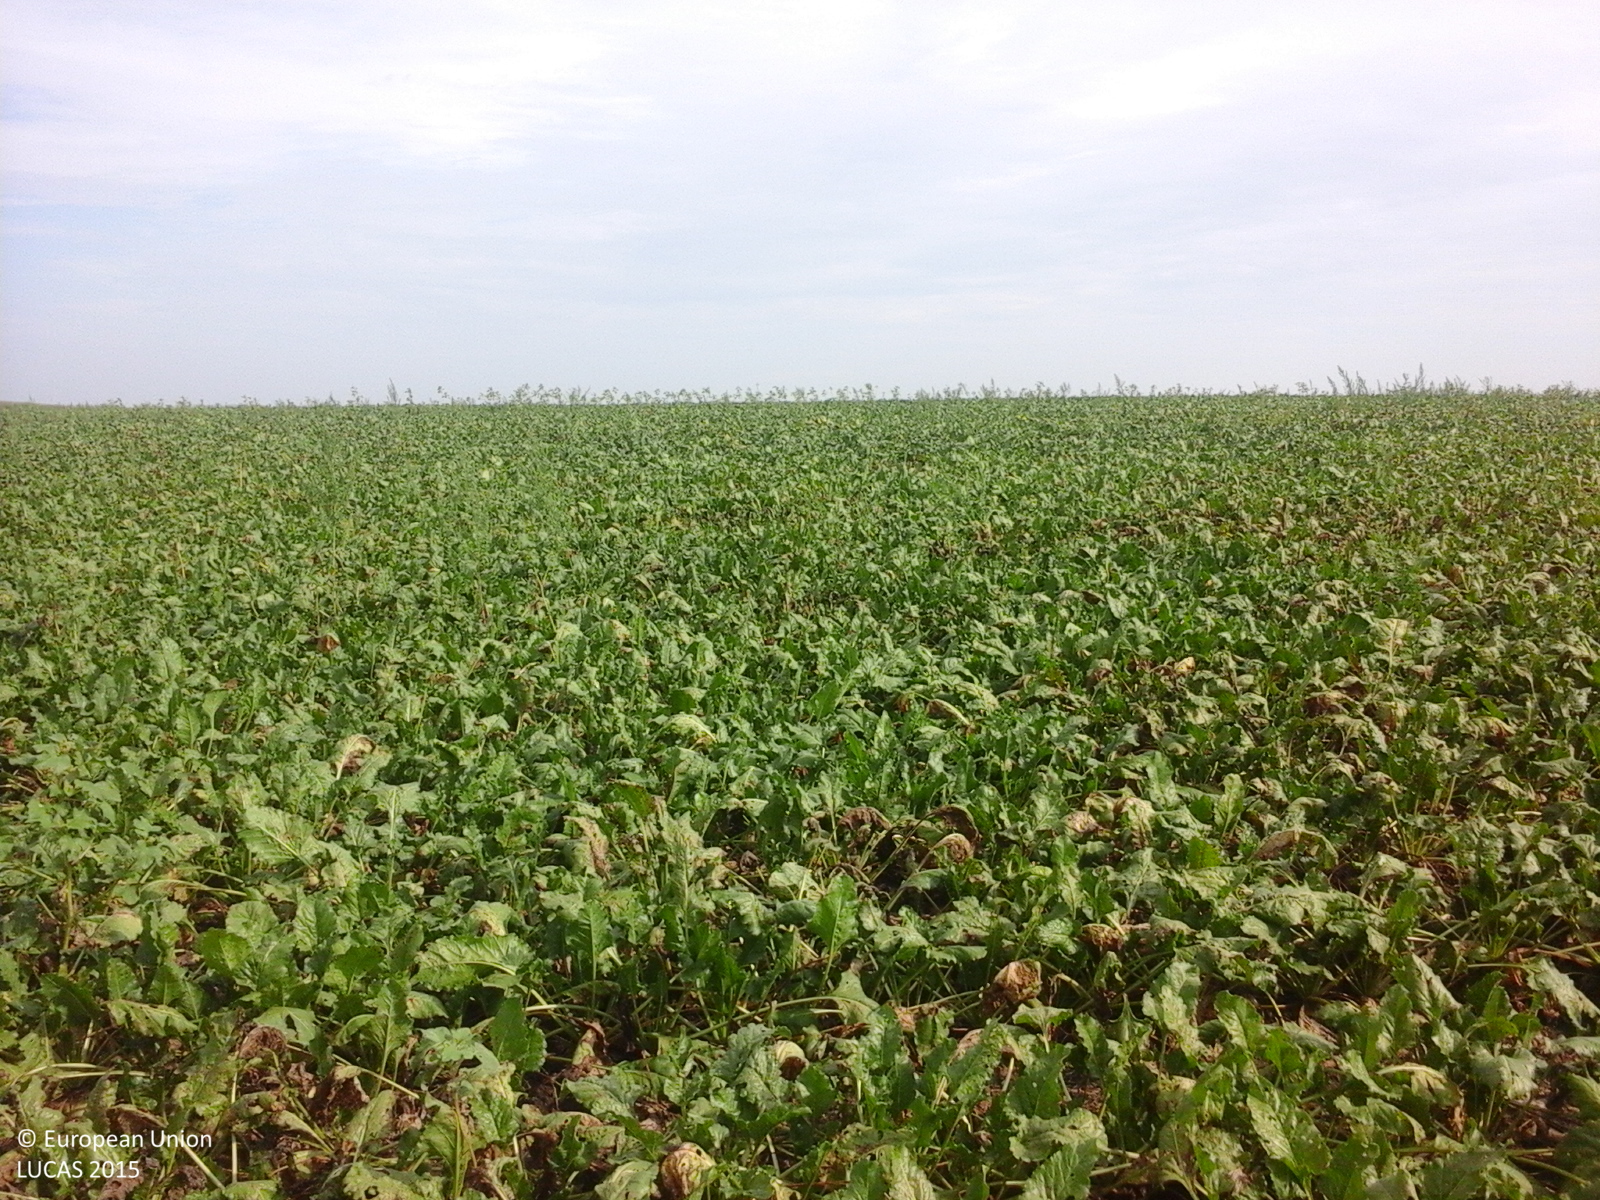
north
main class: Cropland
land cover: Sugar beet
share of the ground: > 75 %
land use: Agriculture (excluding fallow land and kitchen gardens)
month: August
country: RO
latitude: 46.1769
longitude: 20.8712
